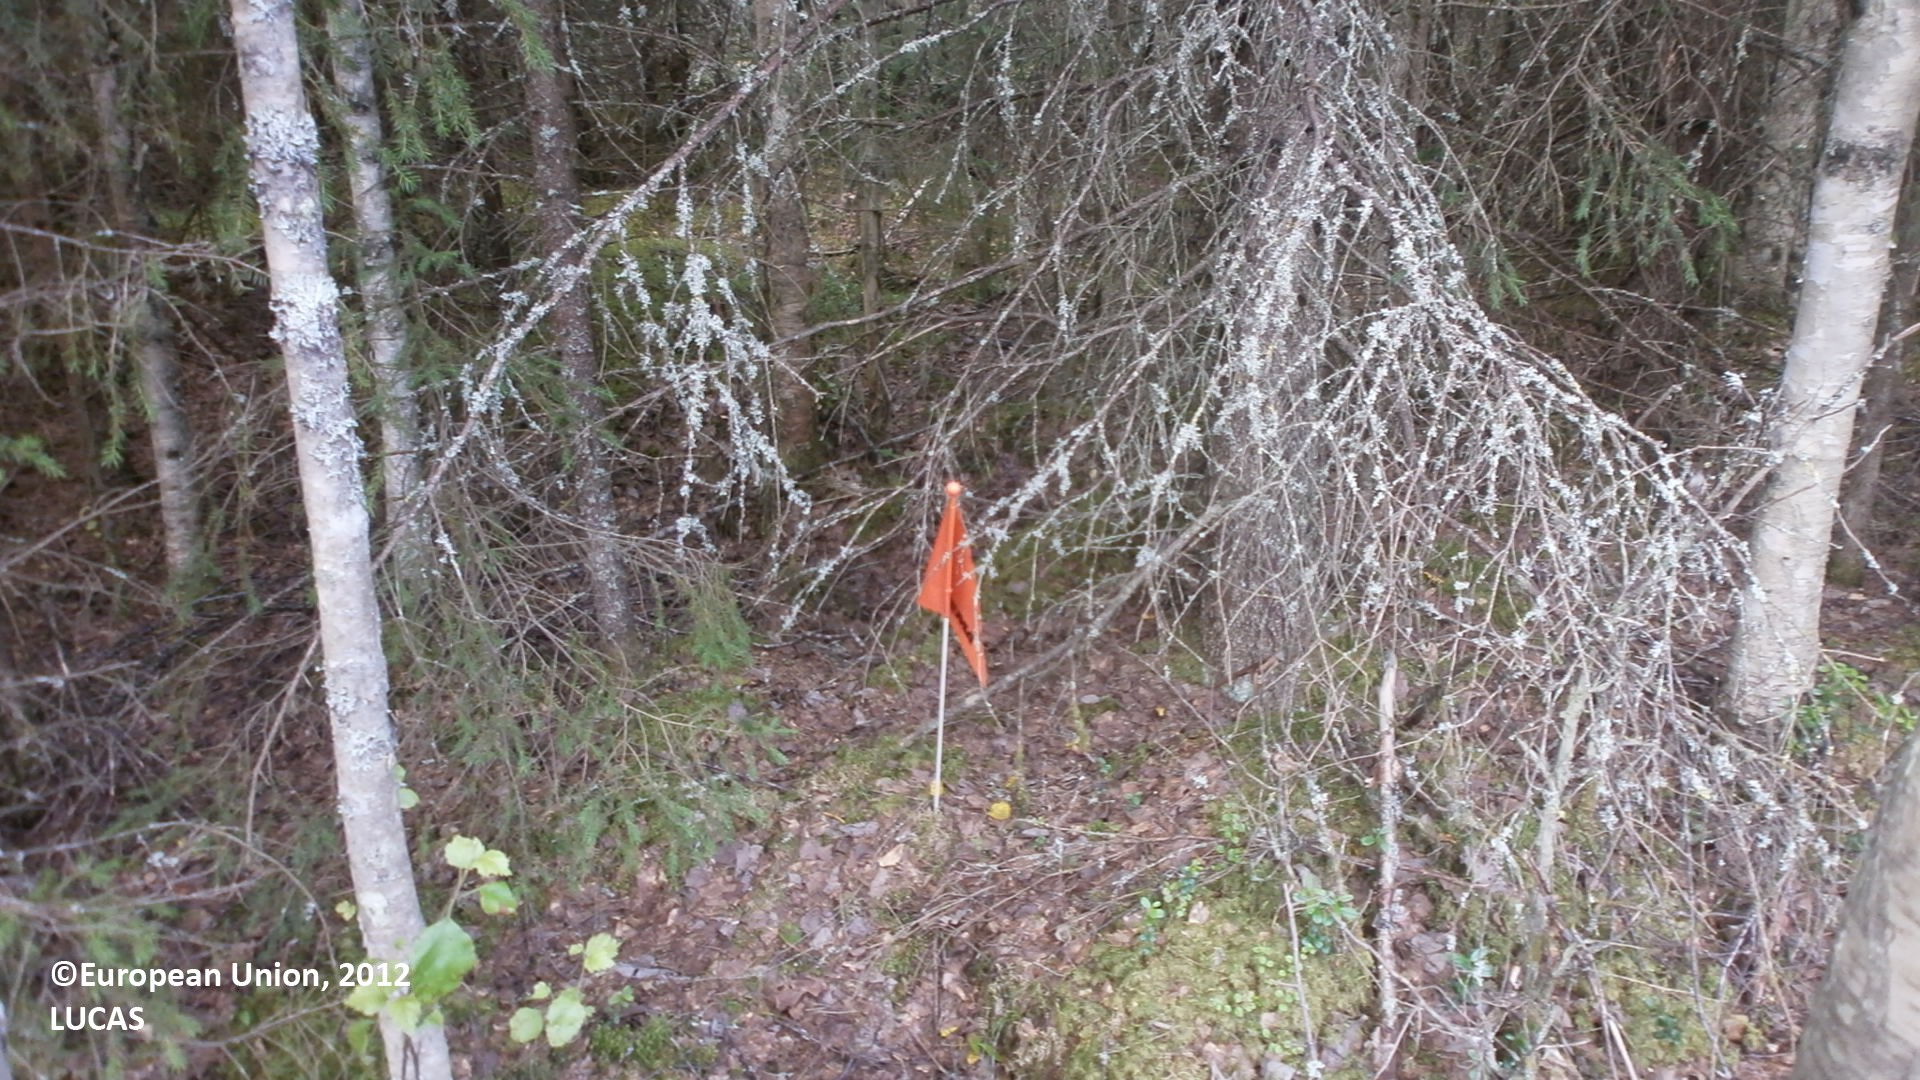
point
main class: Woodland
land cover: Spruce dominated mixed woodland
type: boreal forest
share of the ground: > 75 %
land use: Forestry
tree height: > 5 m
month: July
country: FI
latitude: 64.0230
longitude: 24.2920
